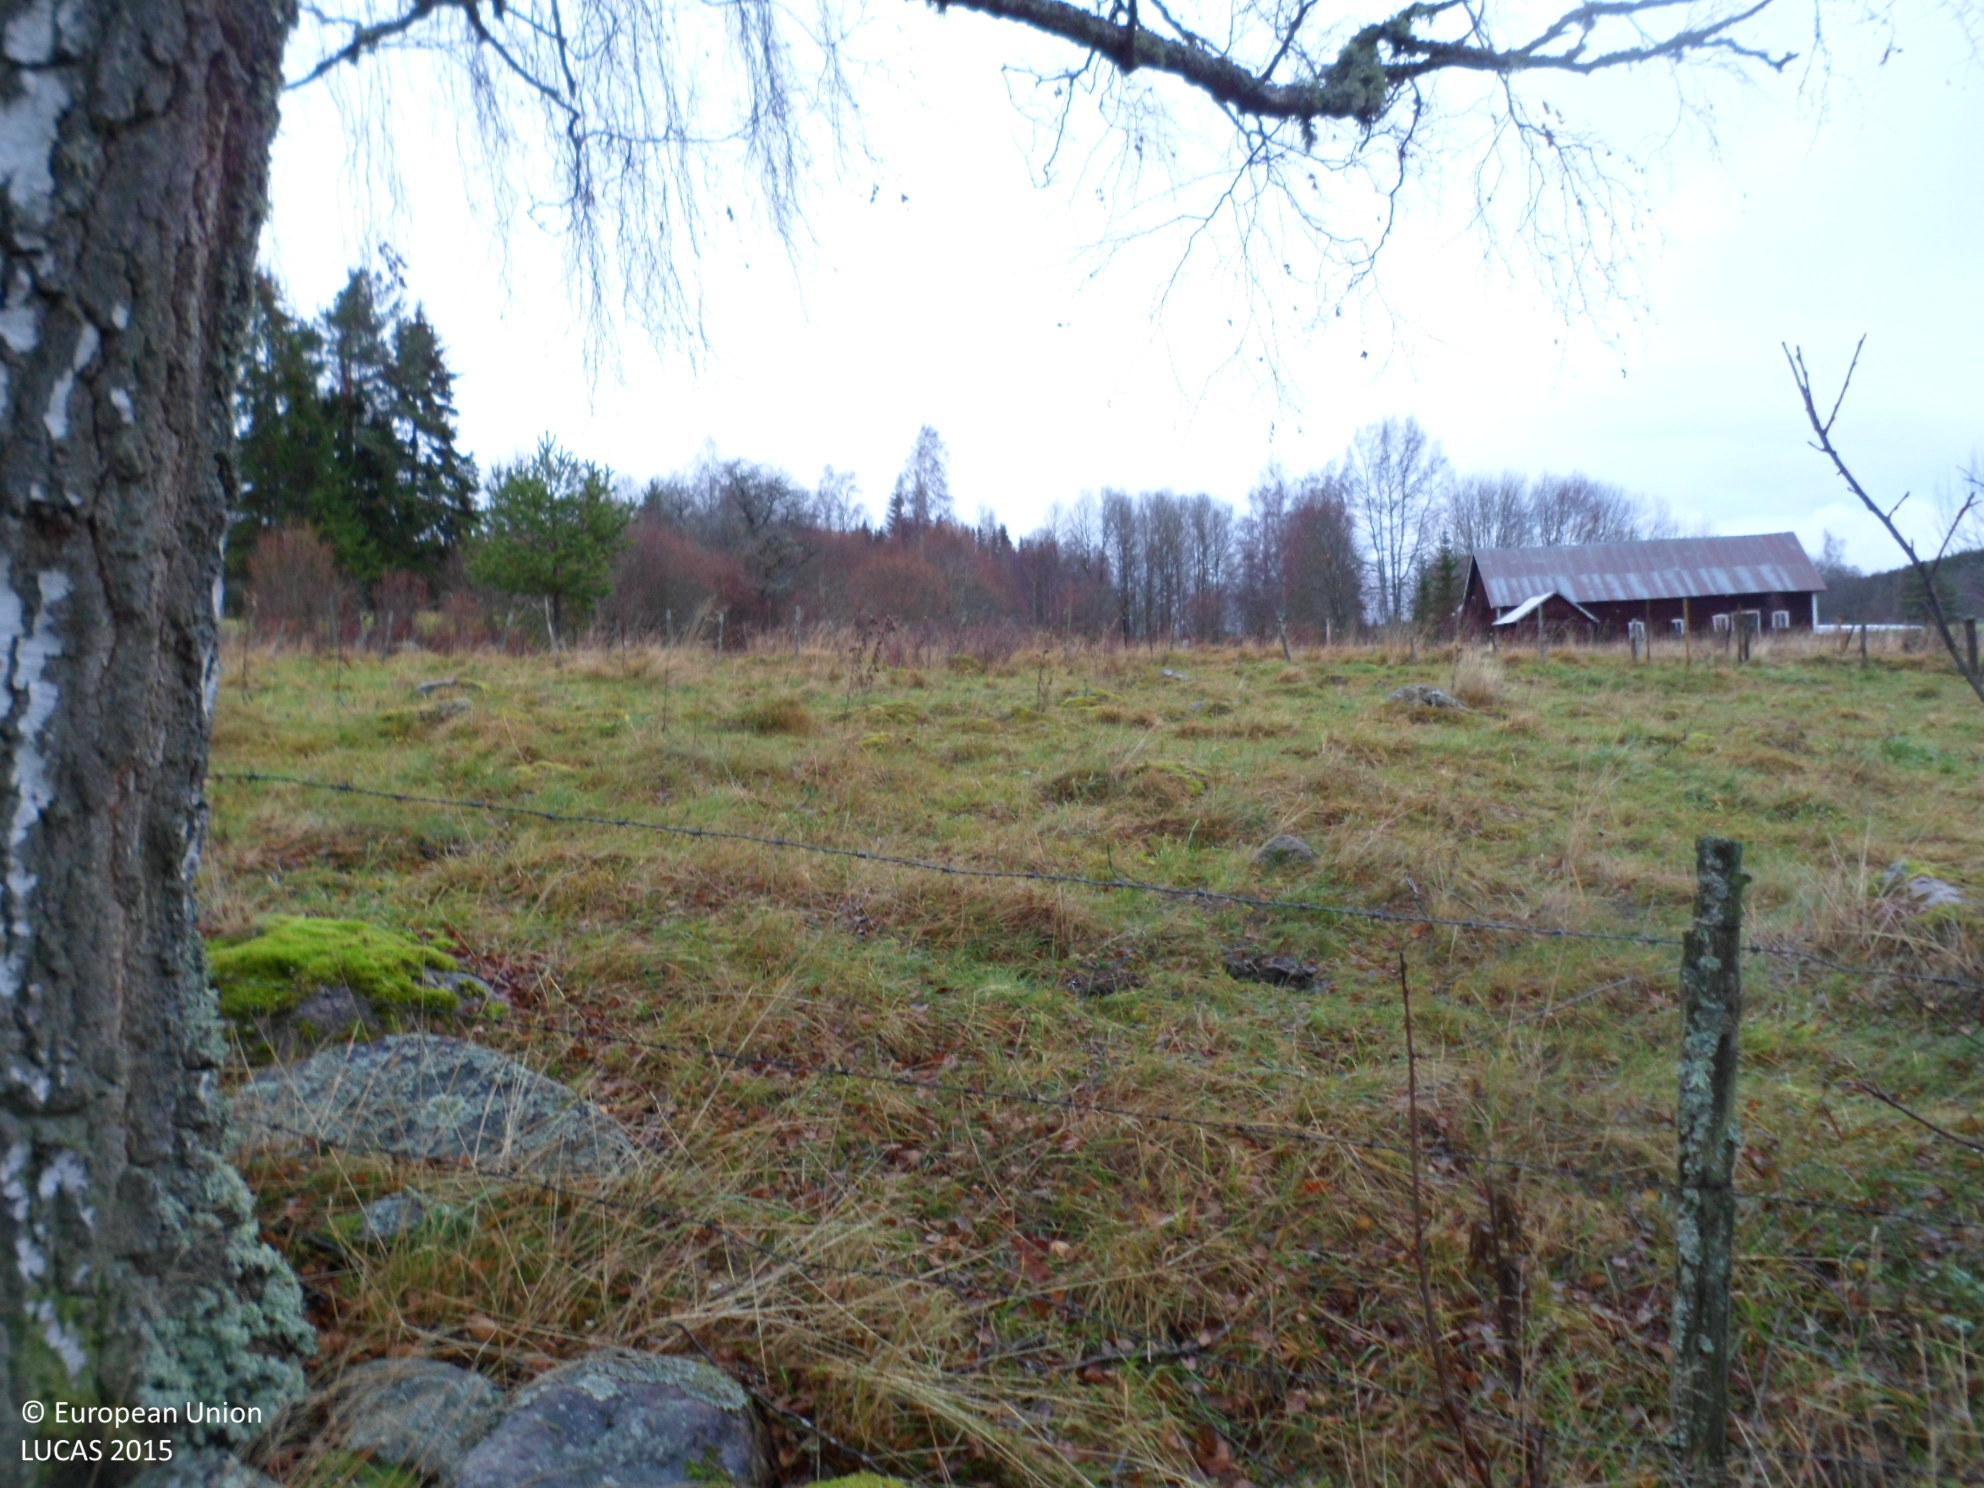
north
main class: Grassland
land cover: Grassland with sparse tree/shrub cover
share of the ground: > 75 %
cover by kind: herbaceous plants 80 %, lichens and mosses 10 %, broadleaved forest trees 5 %, shrubs 5 %
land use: Agriculture (excluding fallow land and kitchen gardens)
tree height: > 5 m
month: November
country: SE
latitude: 57.9951
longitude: 14.6469
